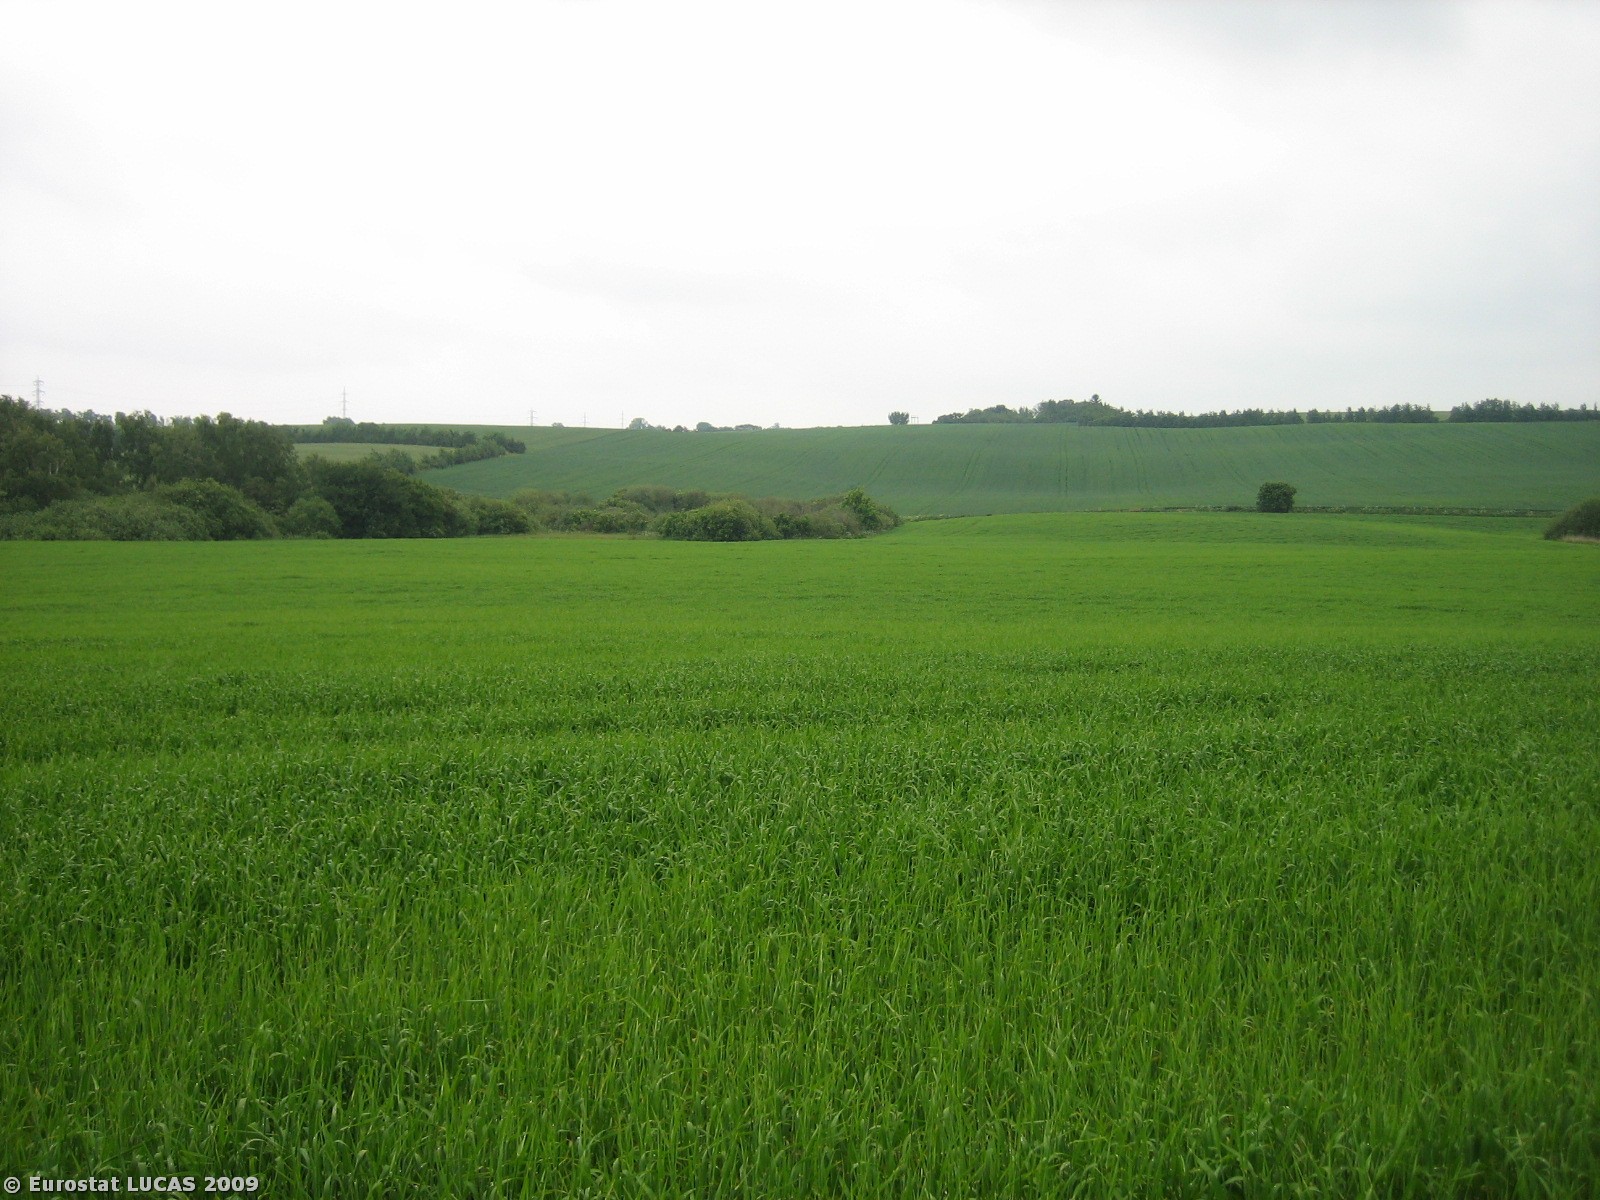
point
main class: Cropland
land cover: Barley
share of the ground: > 75 %
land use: Agriculture (excluding fallow land and kitchen gardens)
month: June
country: DK
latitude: 56.2056
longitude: 10.1449
